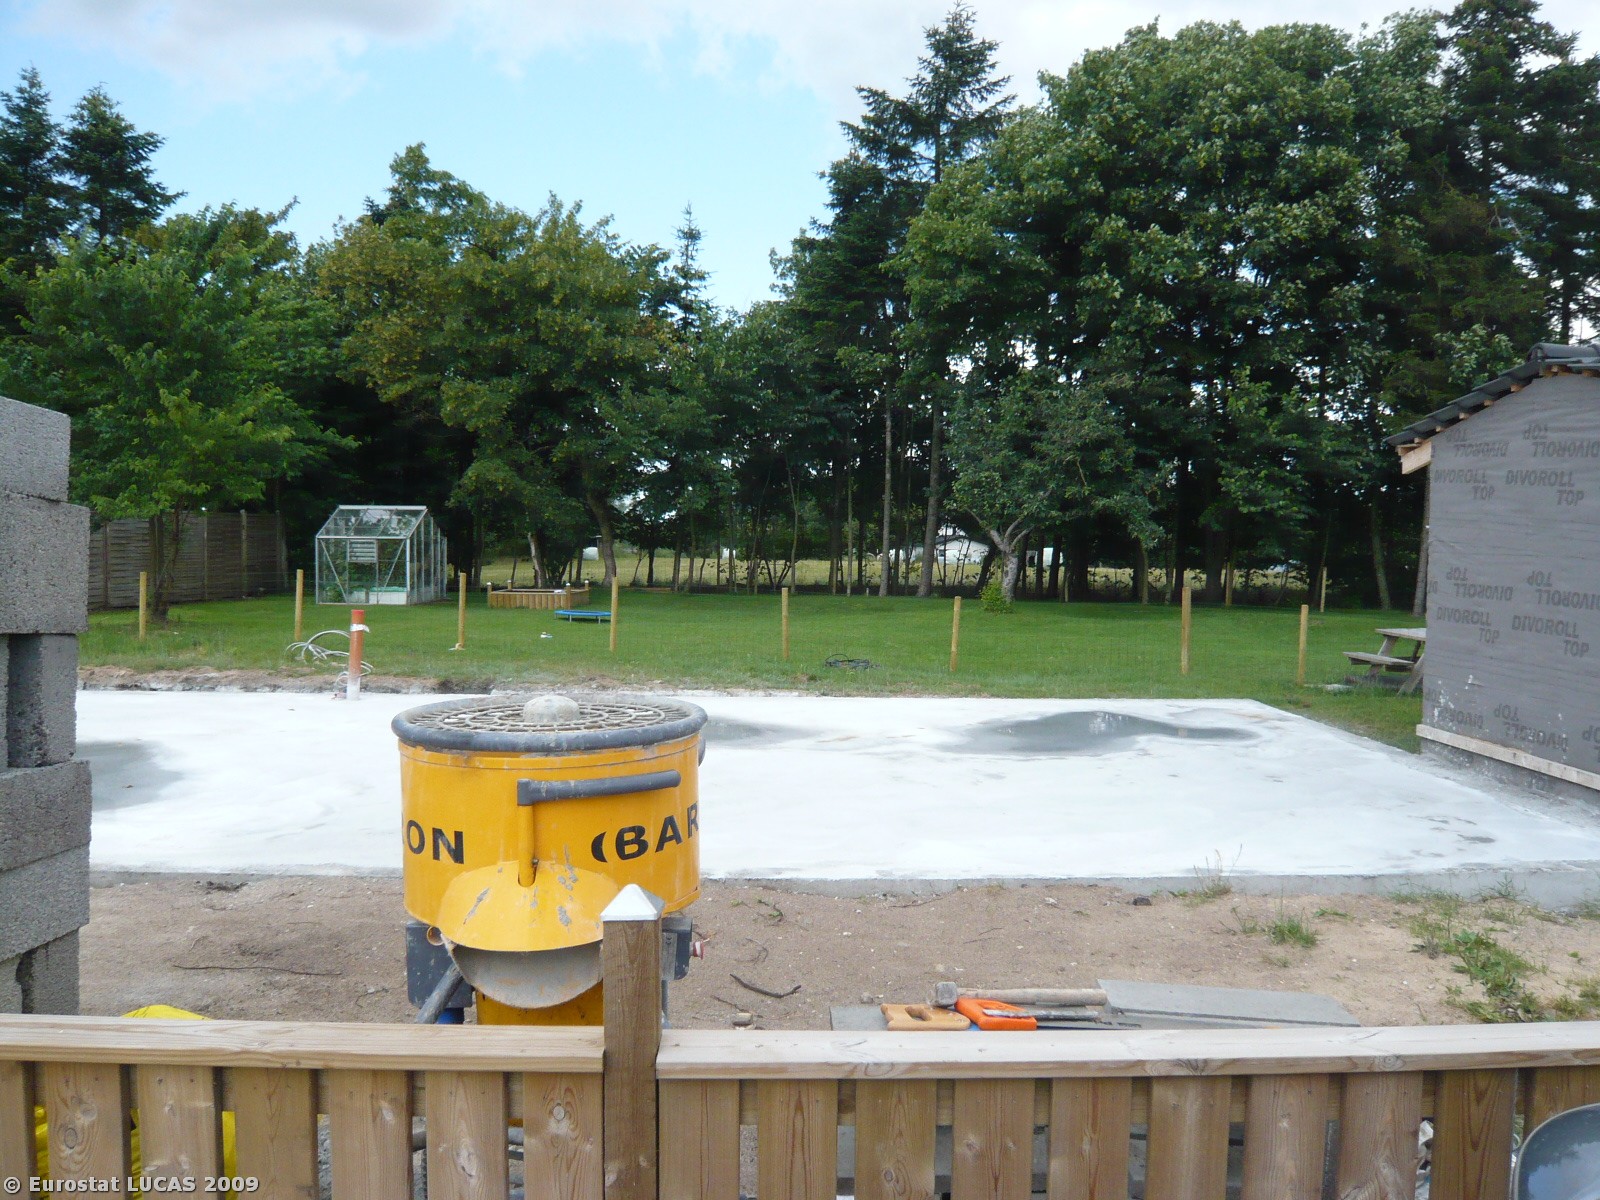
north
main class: Cropland
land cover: Barley
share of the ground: > 75 %
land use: Agriculture (excluding fallow land and kitchen gardens)
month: July
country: DK
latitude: 55.5677
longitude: 11.5051
